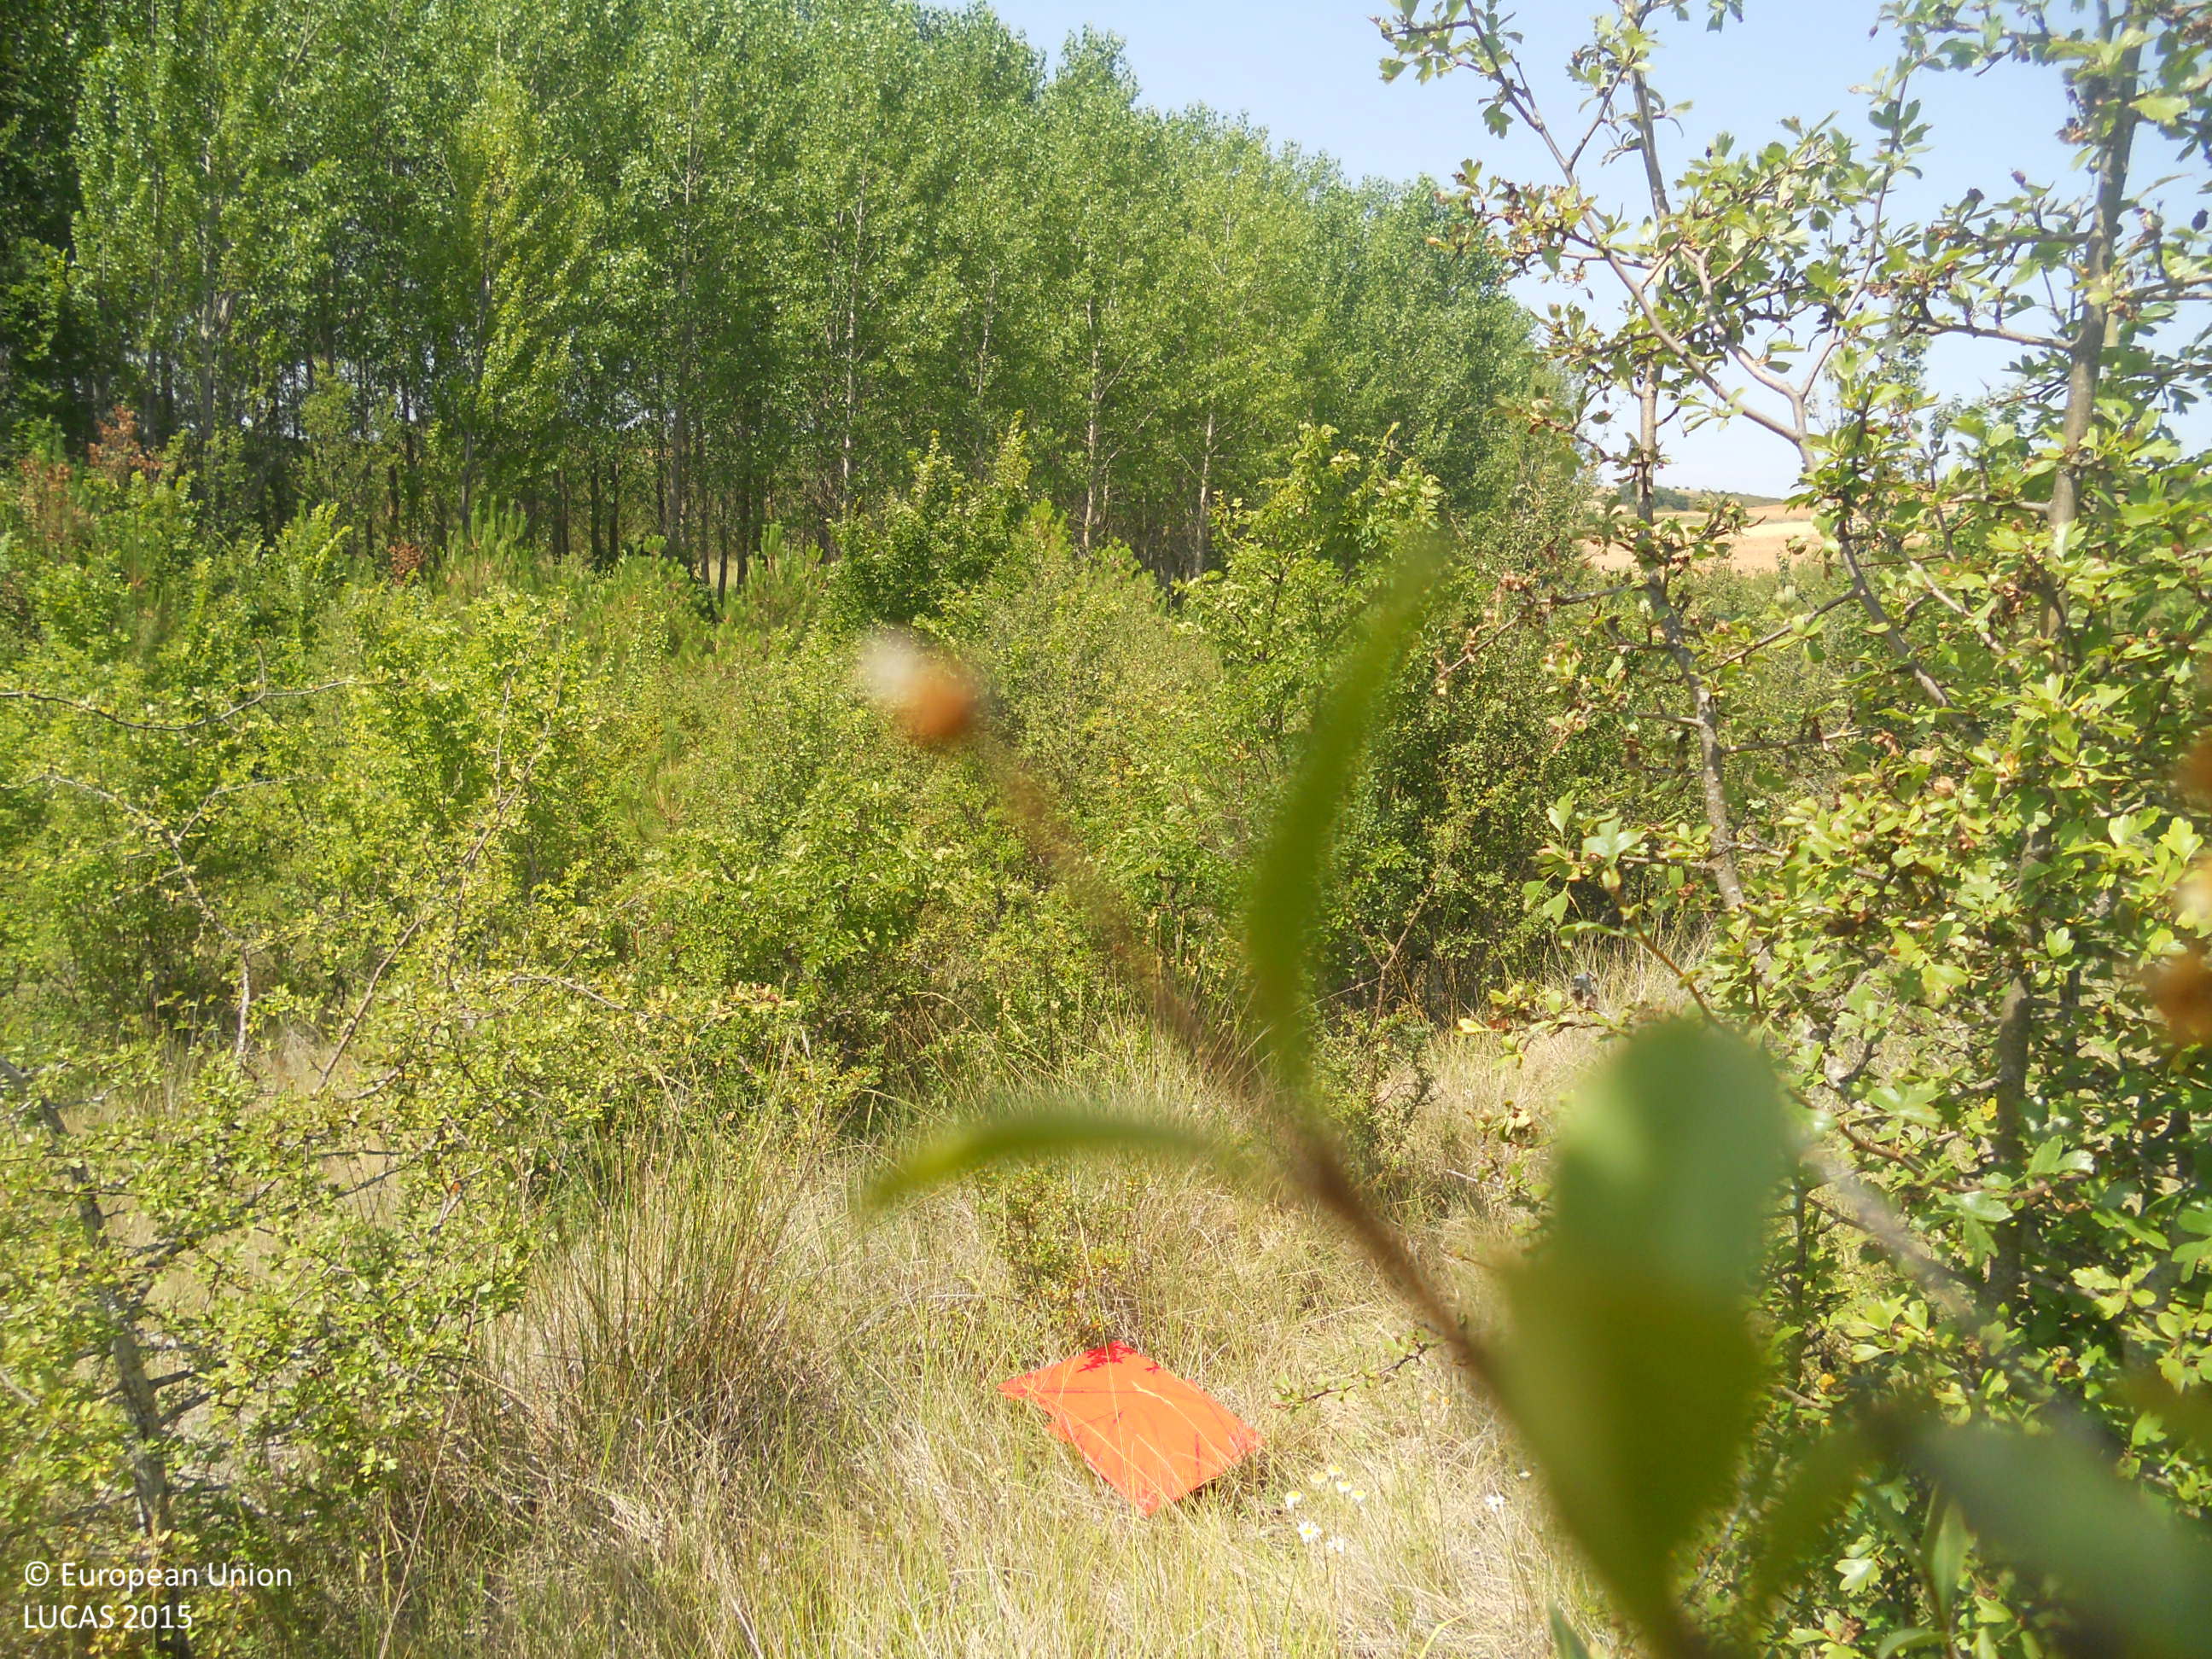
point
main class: Shrubland
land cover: Shrubland with sparse tree cover
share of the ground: > 75 %
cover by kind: shrubs 55 %, herbaceous plants 40 %, coniferous forest trees 5 %
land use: Semi-natural and natural areas not in use
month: July
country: ES
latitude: 42.5932
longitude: -5.3627
